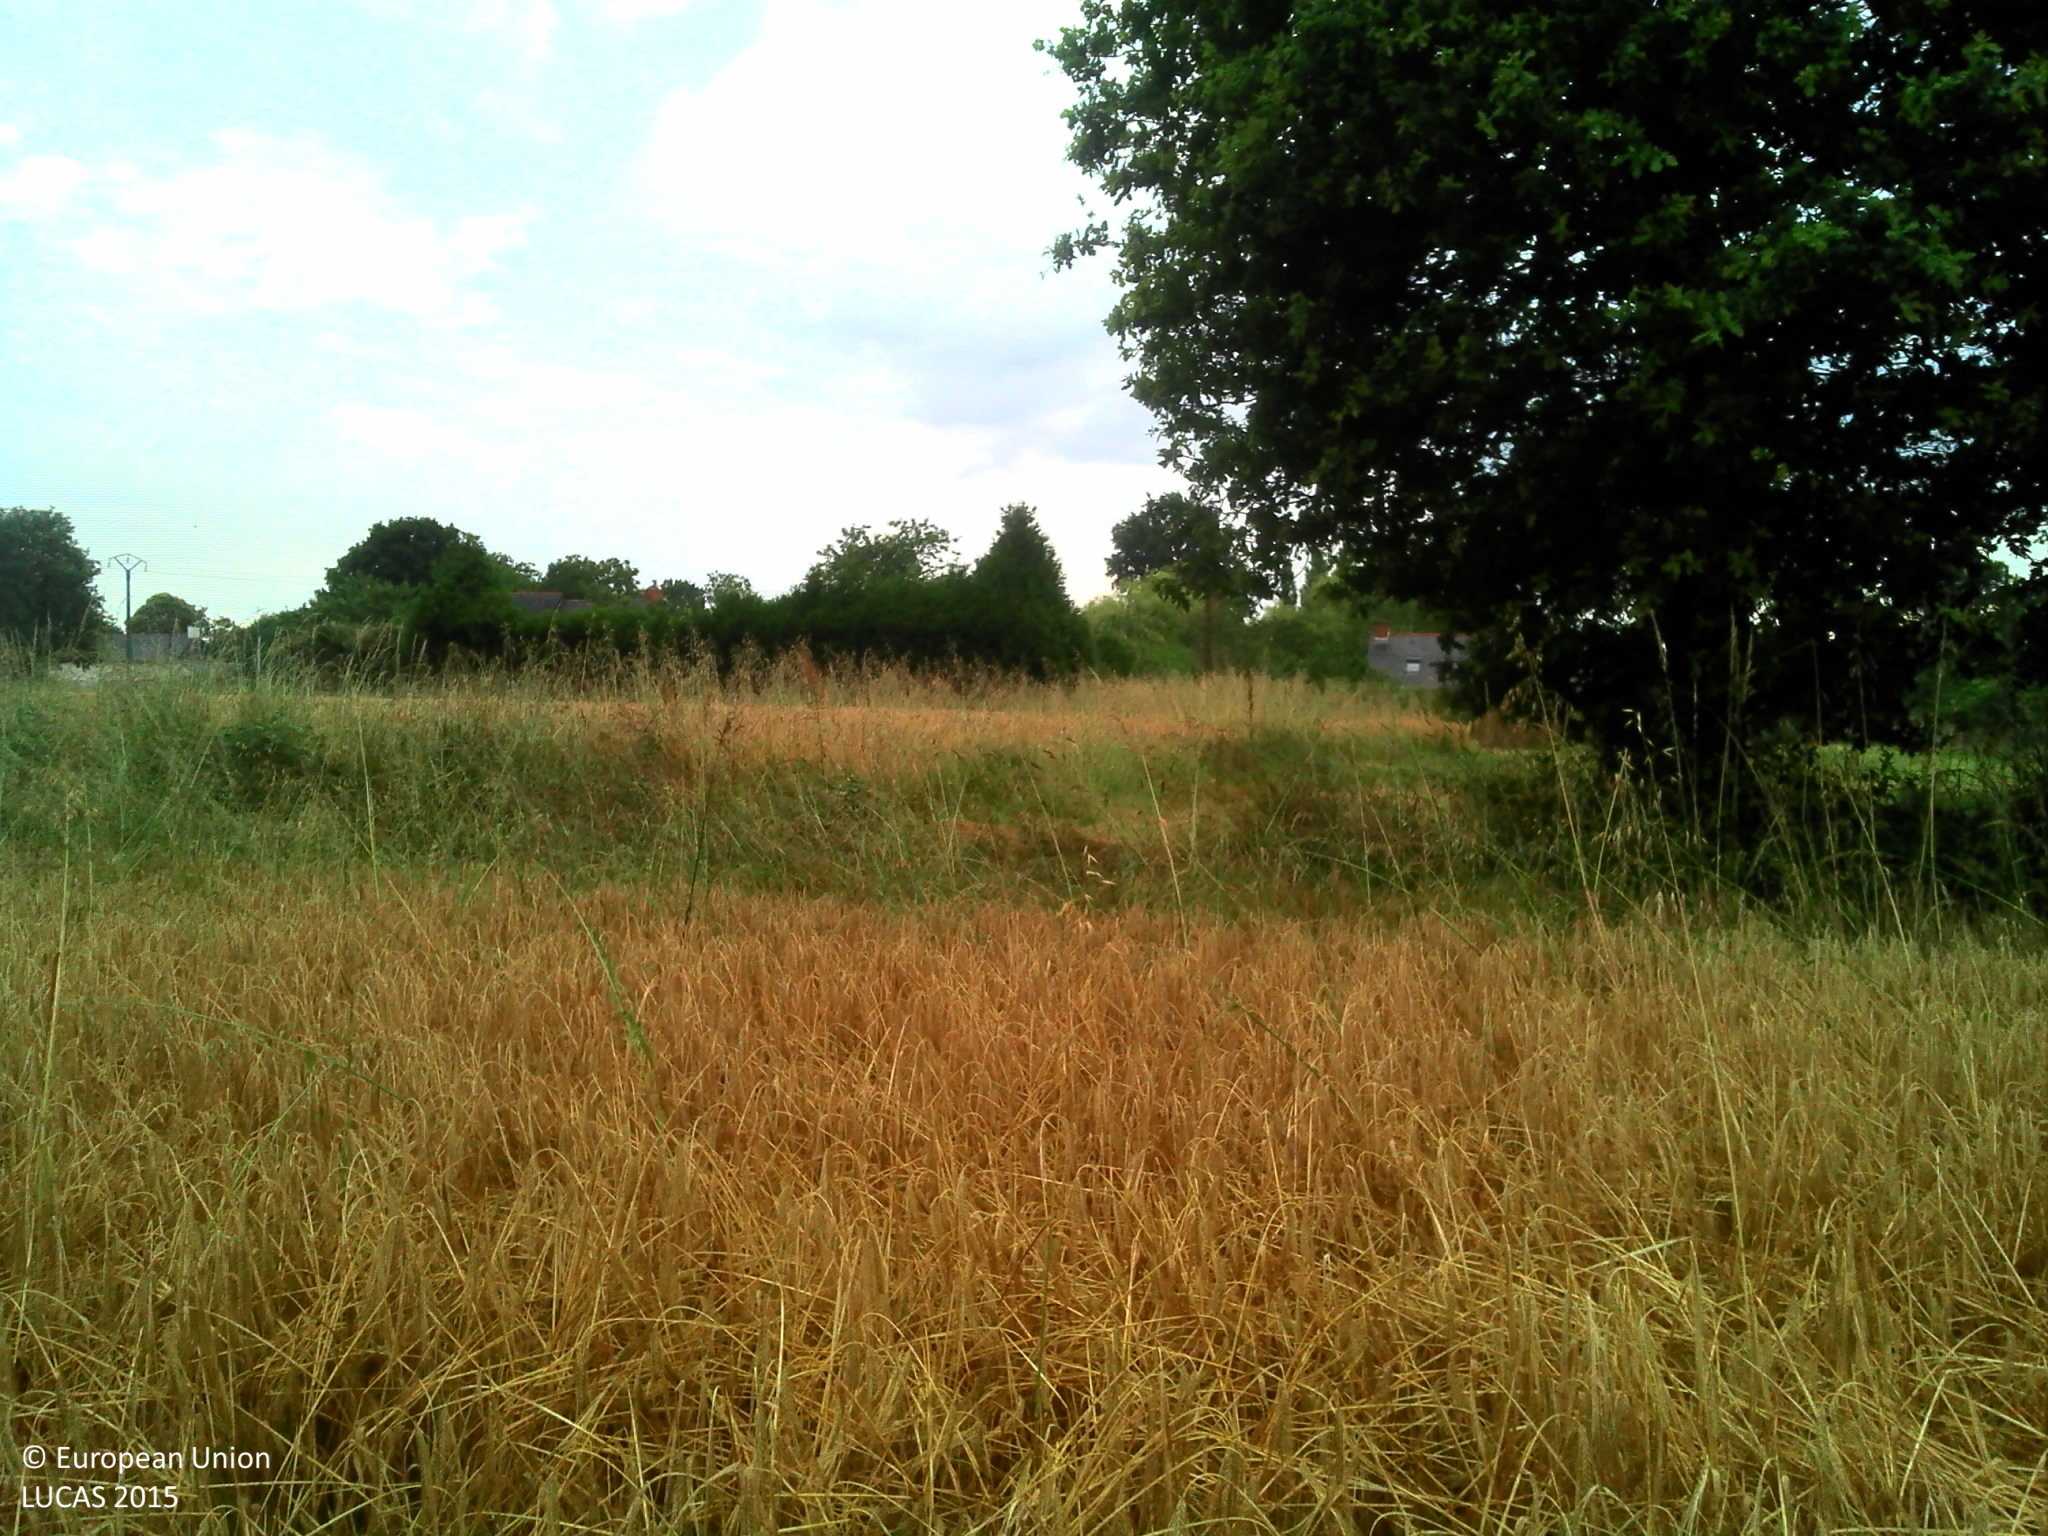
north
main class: Cropland
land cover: Barley
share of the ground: > 75 %
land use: Agriculture (excluding fallow land and kitchen gardens)
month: July
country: FR
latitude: 48.3265
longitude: -1.6889
